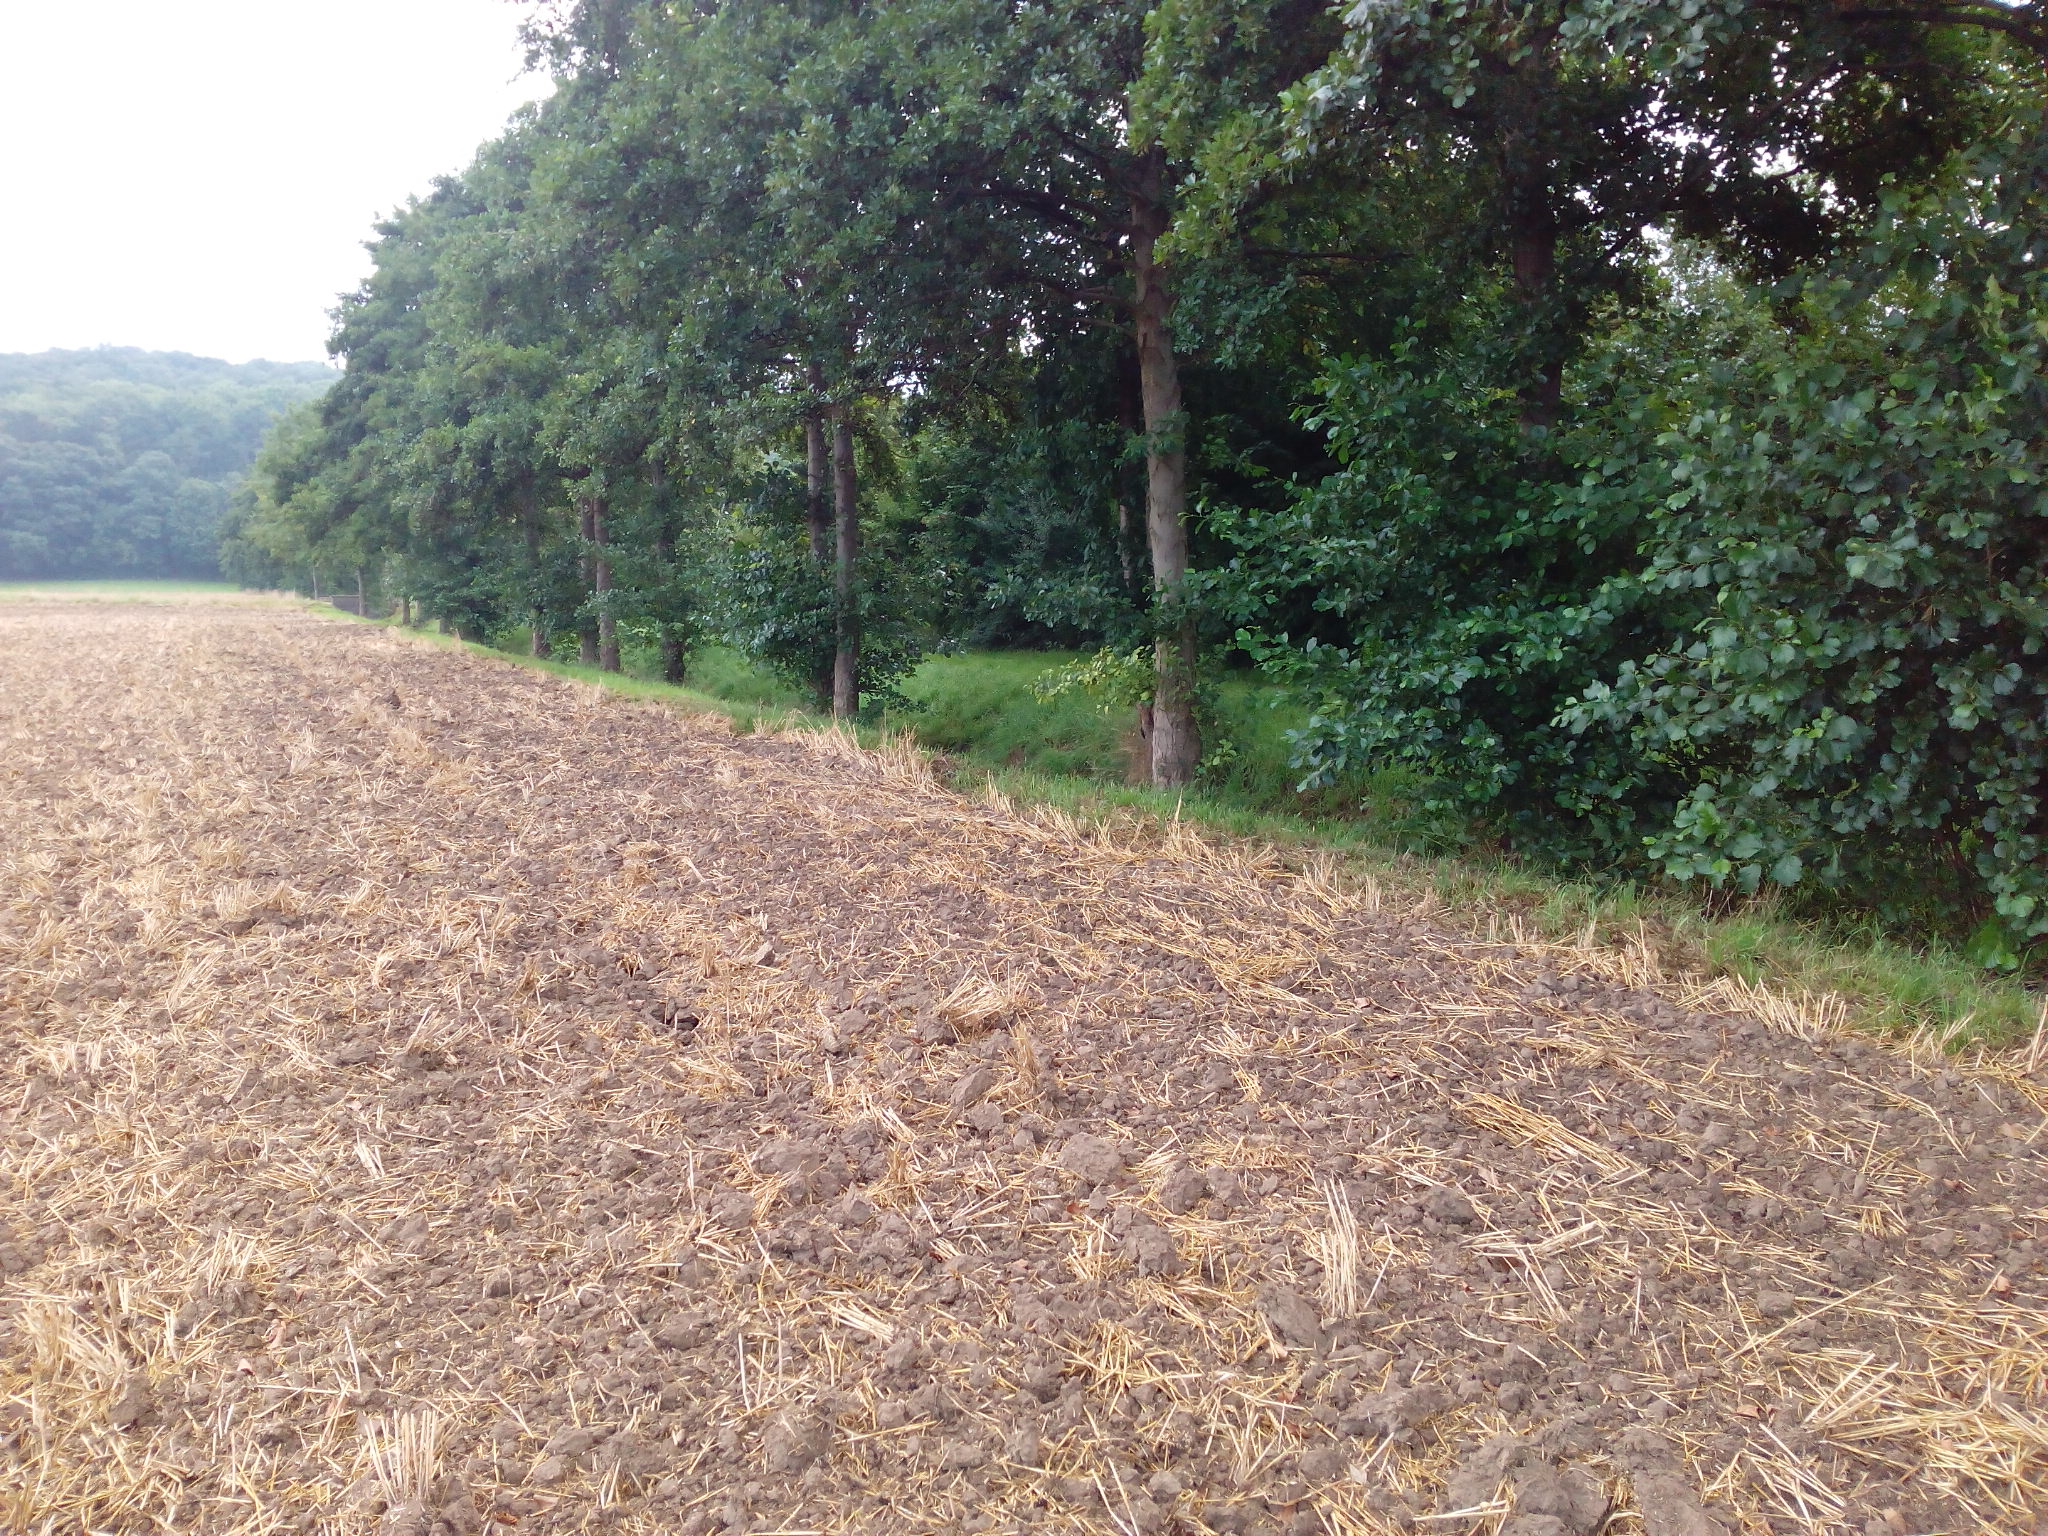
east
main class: Cropland
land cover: Common wheat
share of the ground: < 10 %
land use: Agriculture (excluding fallow land and kitchen gardens)
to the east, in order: Common wheat; Lines of trees; Ditches and canals; Grass margins; Tracks; Abandoned hedges; Common wheat
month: August
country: DE
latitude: 52.1258
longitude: 9.9270
